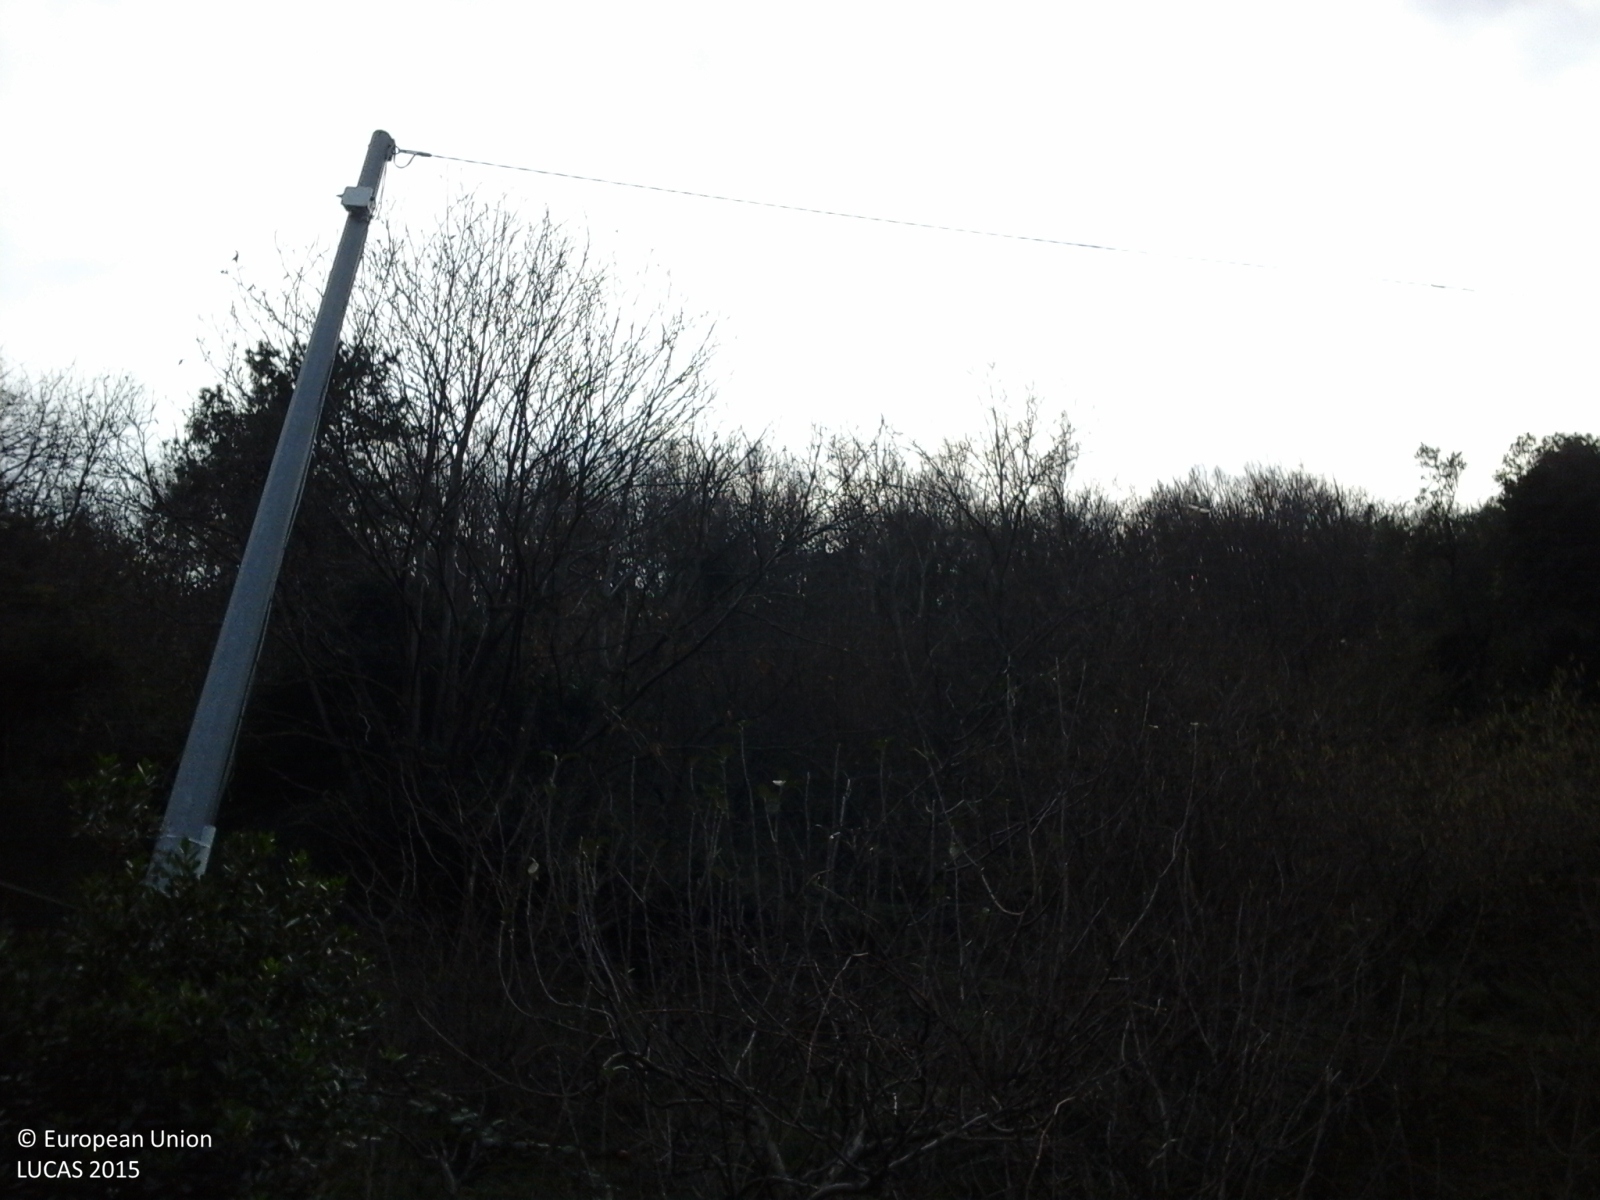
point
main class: Woodland
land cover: Broadleaved woodland
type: thermophilous deciduous forest
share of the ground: > 75 %
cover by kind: broadleaved forest trees 75 %, coniferous forest trees 10 %, shrubs 10 %, herbaceous plants 5 %
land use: Forestry
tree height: > 5 m
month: October
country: IT
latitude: 44.1875
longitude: 9.6131
